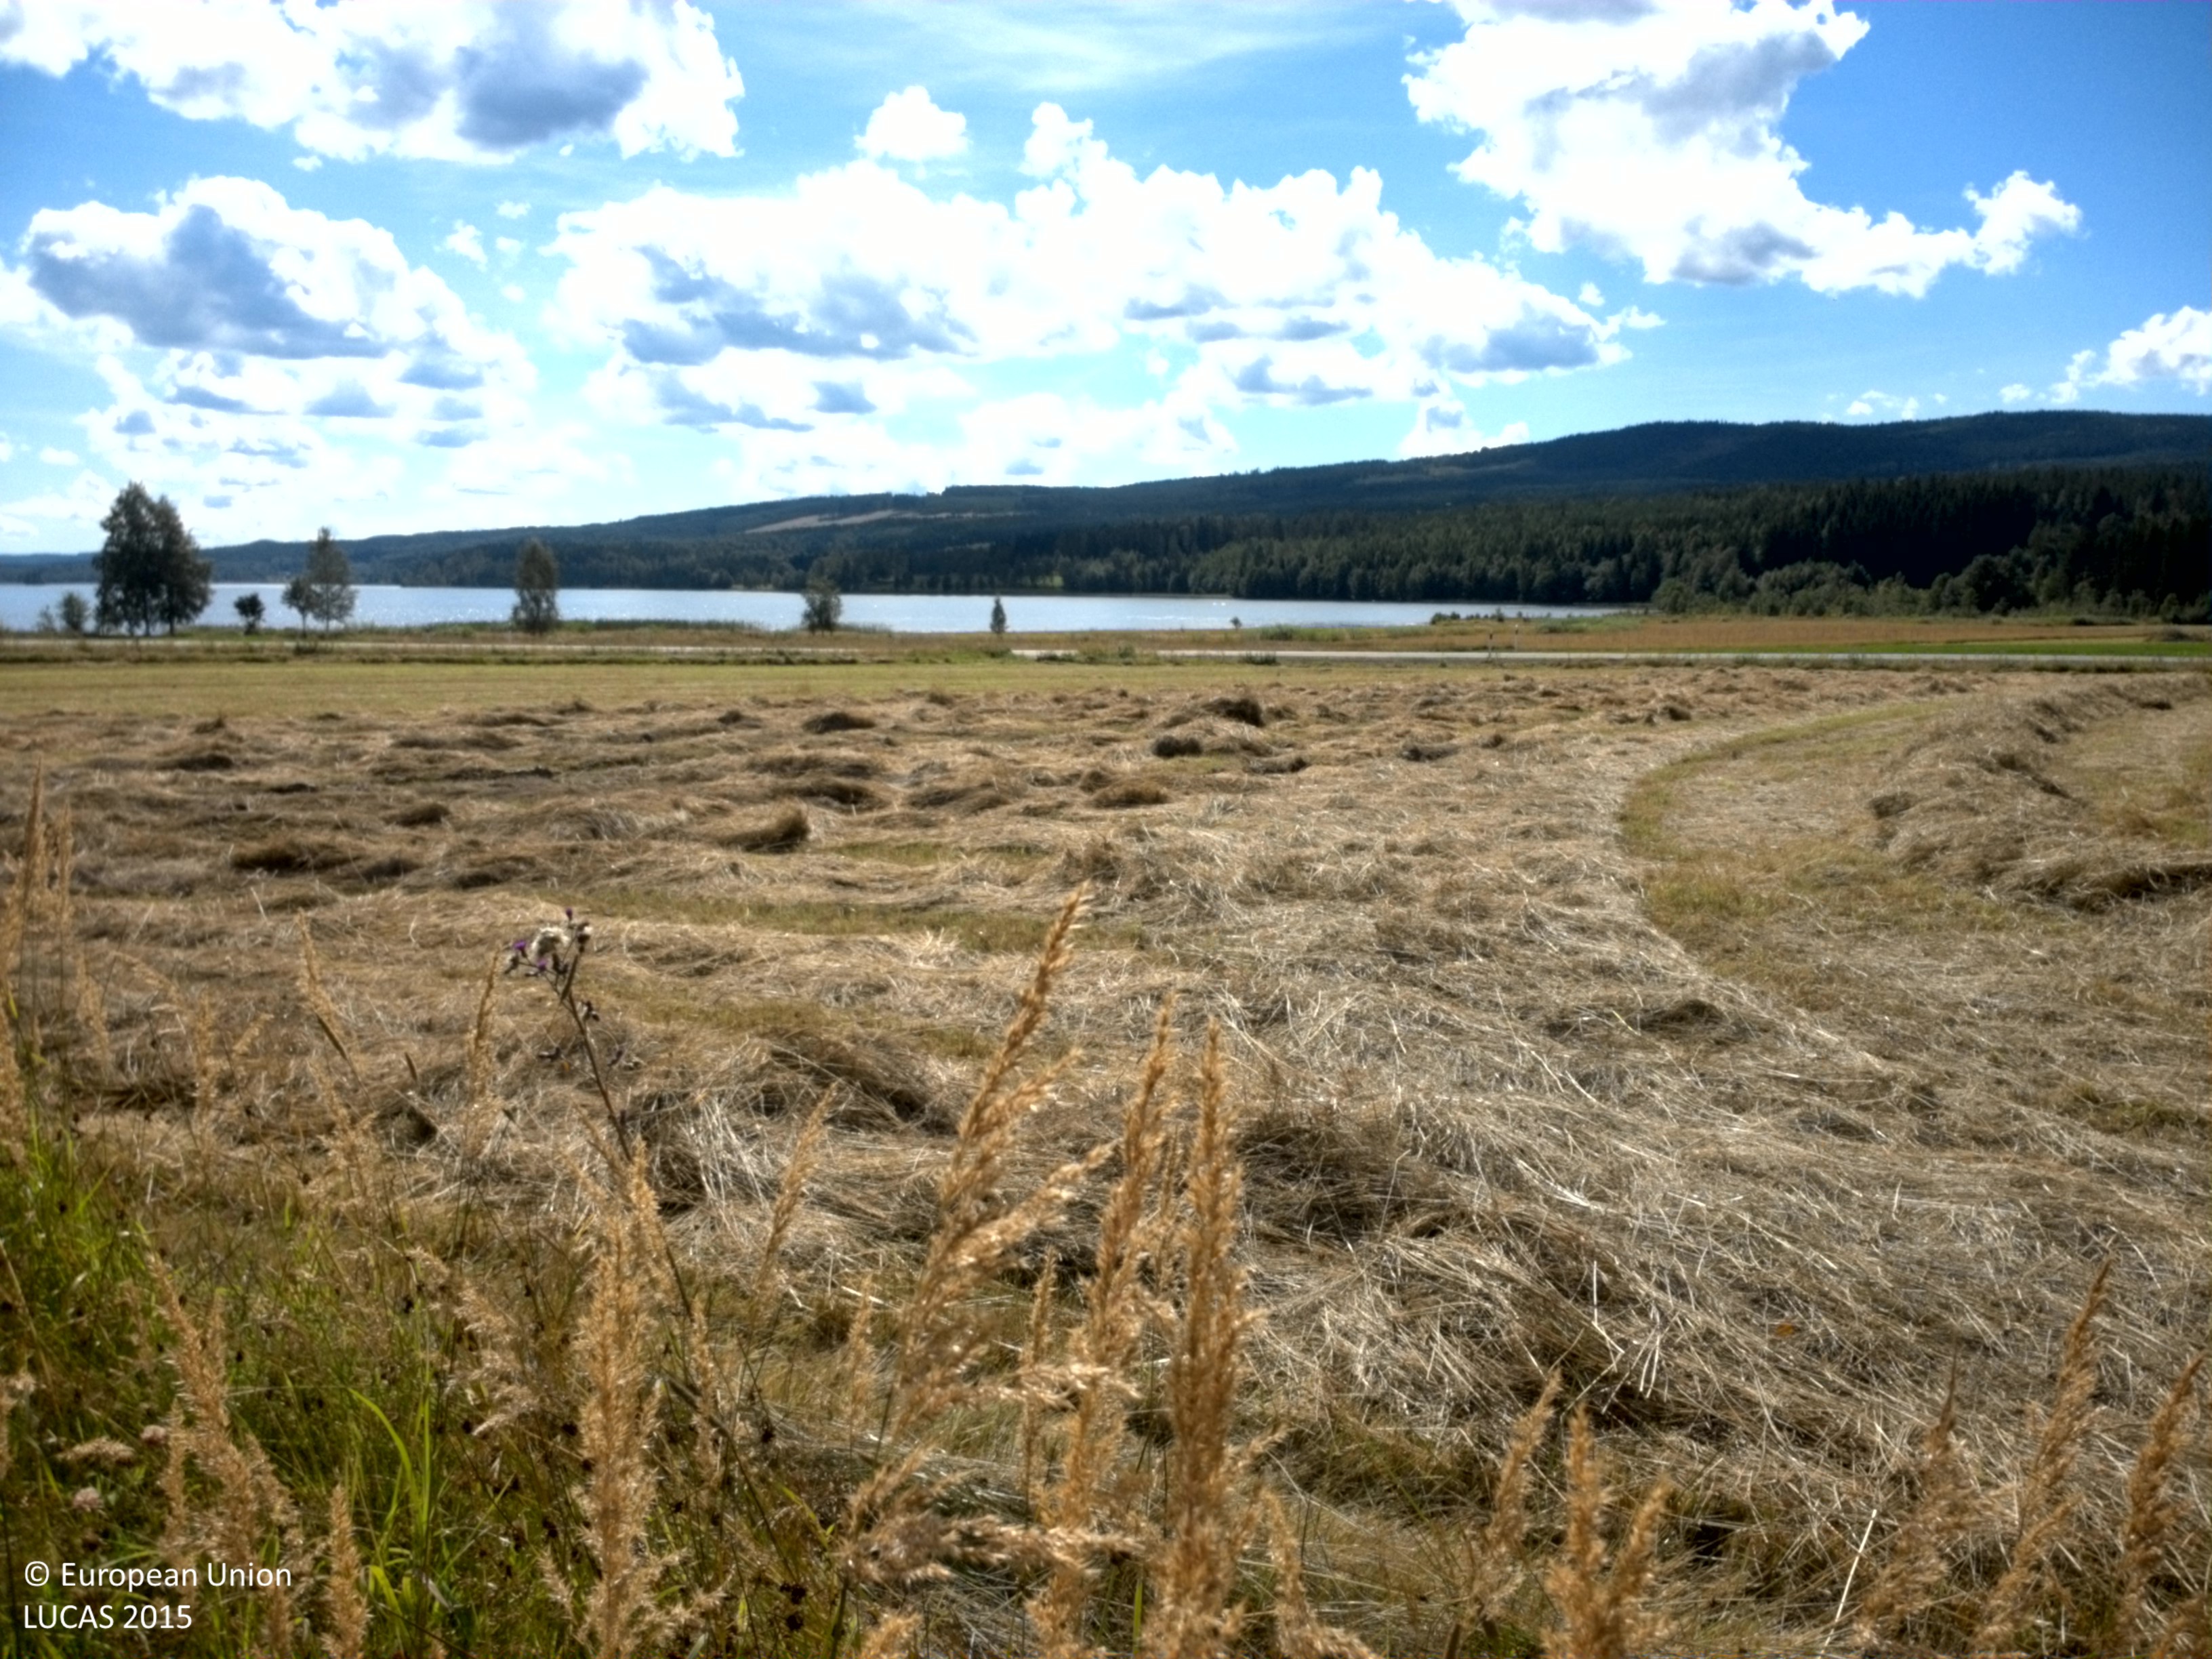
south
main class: Grassland
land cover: Grassland with sparse tree/shrub cover
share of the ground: > 75 %
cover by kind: herbaceous plants 85 %, shrubs 10 %, broadleaved forest trees 5 %
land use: Semi-natural and natural areas not in use
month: August
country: SE
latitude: 60.1758
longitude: 13.3975
